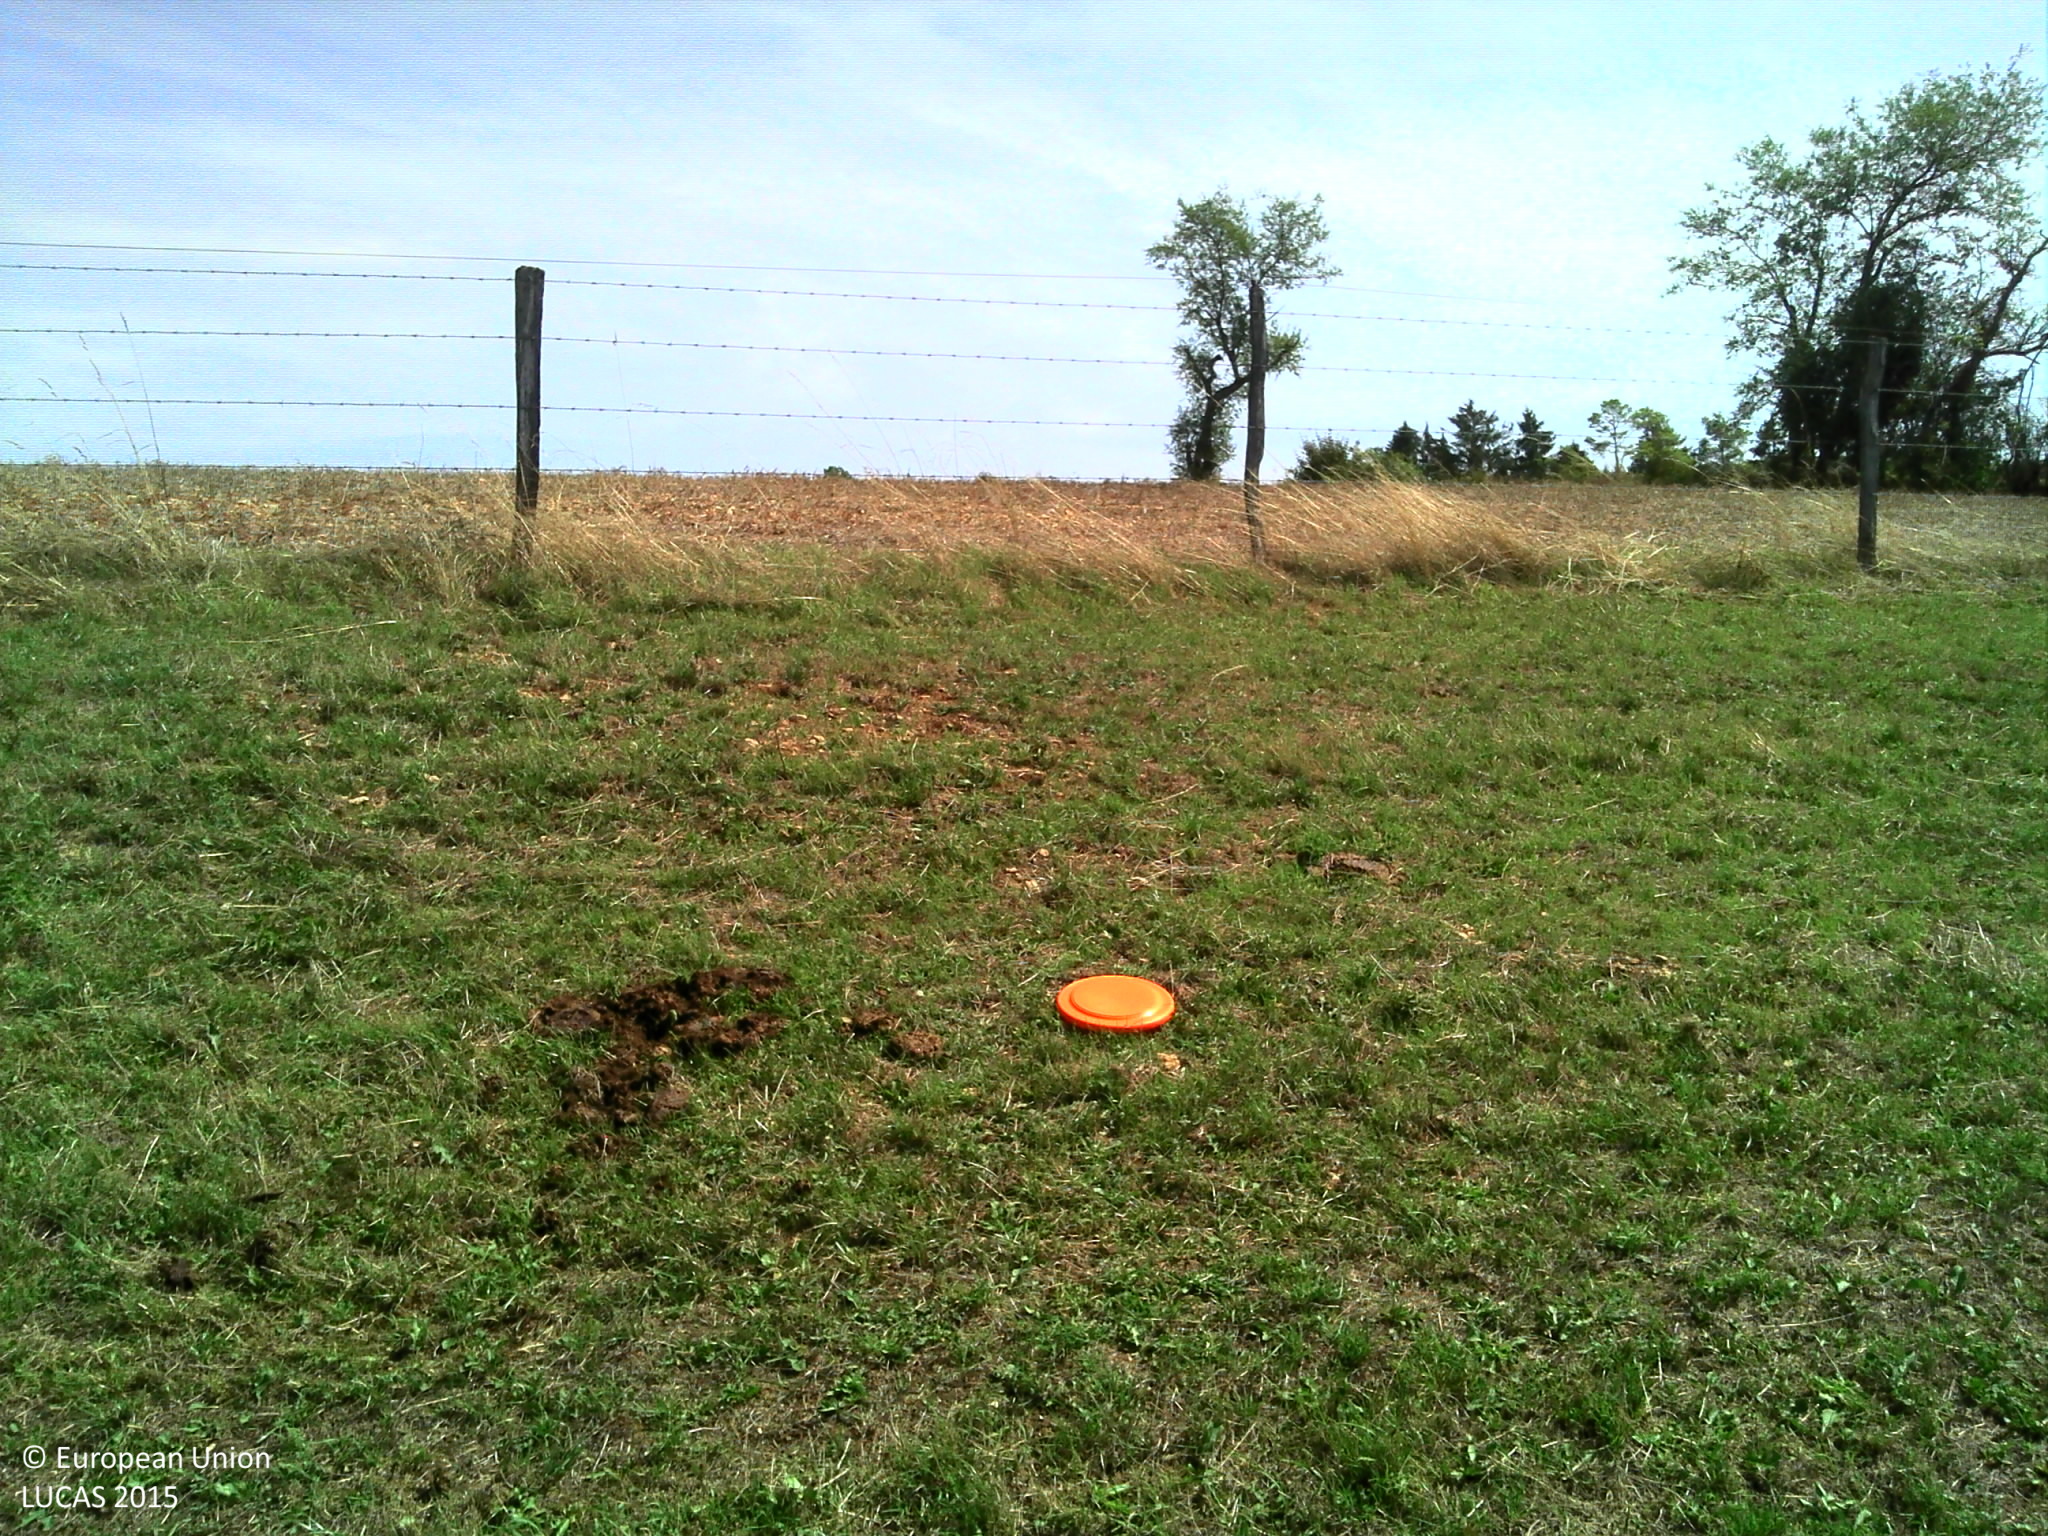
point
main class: Grassland
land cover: Grassland without tree/shrub cover
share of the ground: > 75 %
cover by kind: herbaceous plants 100 %
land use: Agriculture (excluding fallow land and kitchen gardens)
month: August
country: FR
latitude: 47.7470
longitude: 4.9445
